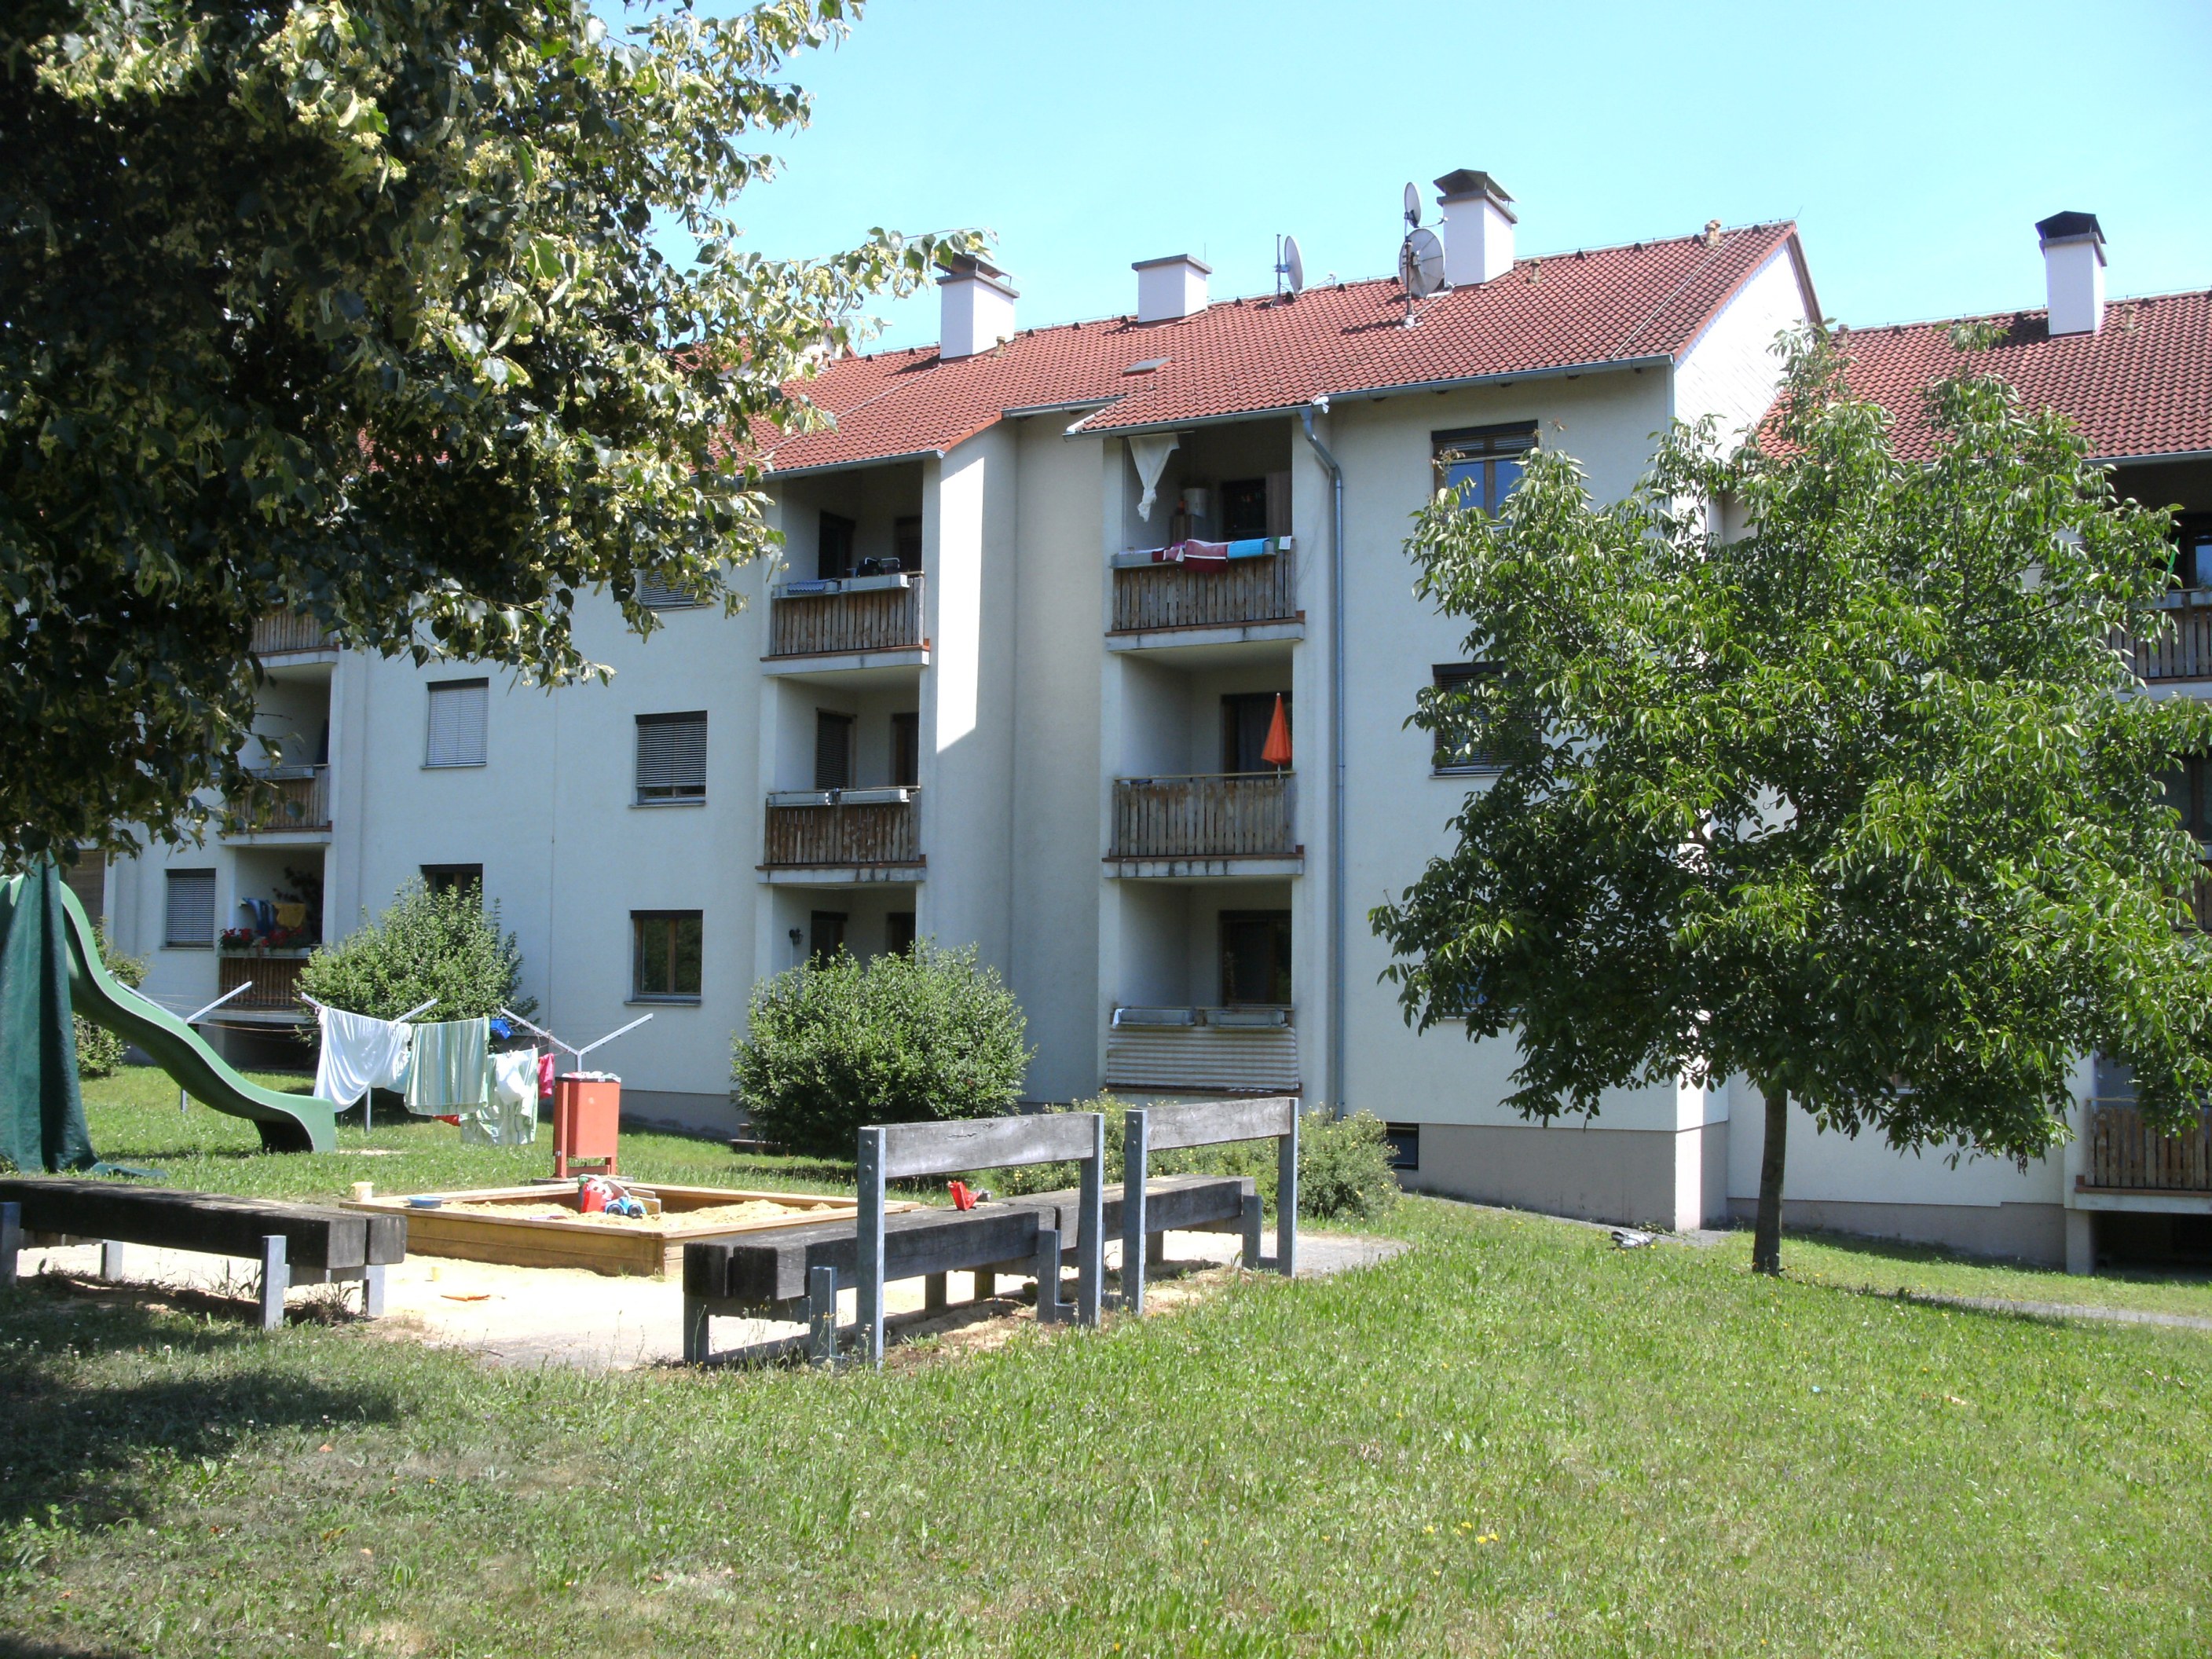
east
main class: Grassland
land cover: Grassland with sparse tree/shrub cover
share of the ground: > 75 %
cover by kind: herbaceous plants 95 %, broadleaved forest trees 5 %
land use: Residential
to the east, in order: Grassland with sparse tree/shrub cover; Artificial constructions in urban areas; Grassland without tree/shrub cover; Artificial constructions in urban areas; Grassland without tree/shrub cover
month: June
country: AT
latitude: 48.2118
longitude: 13.8080
